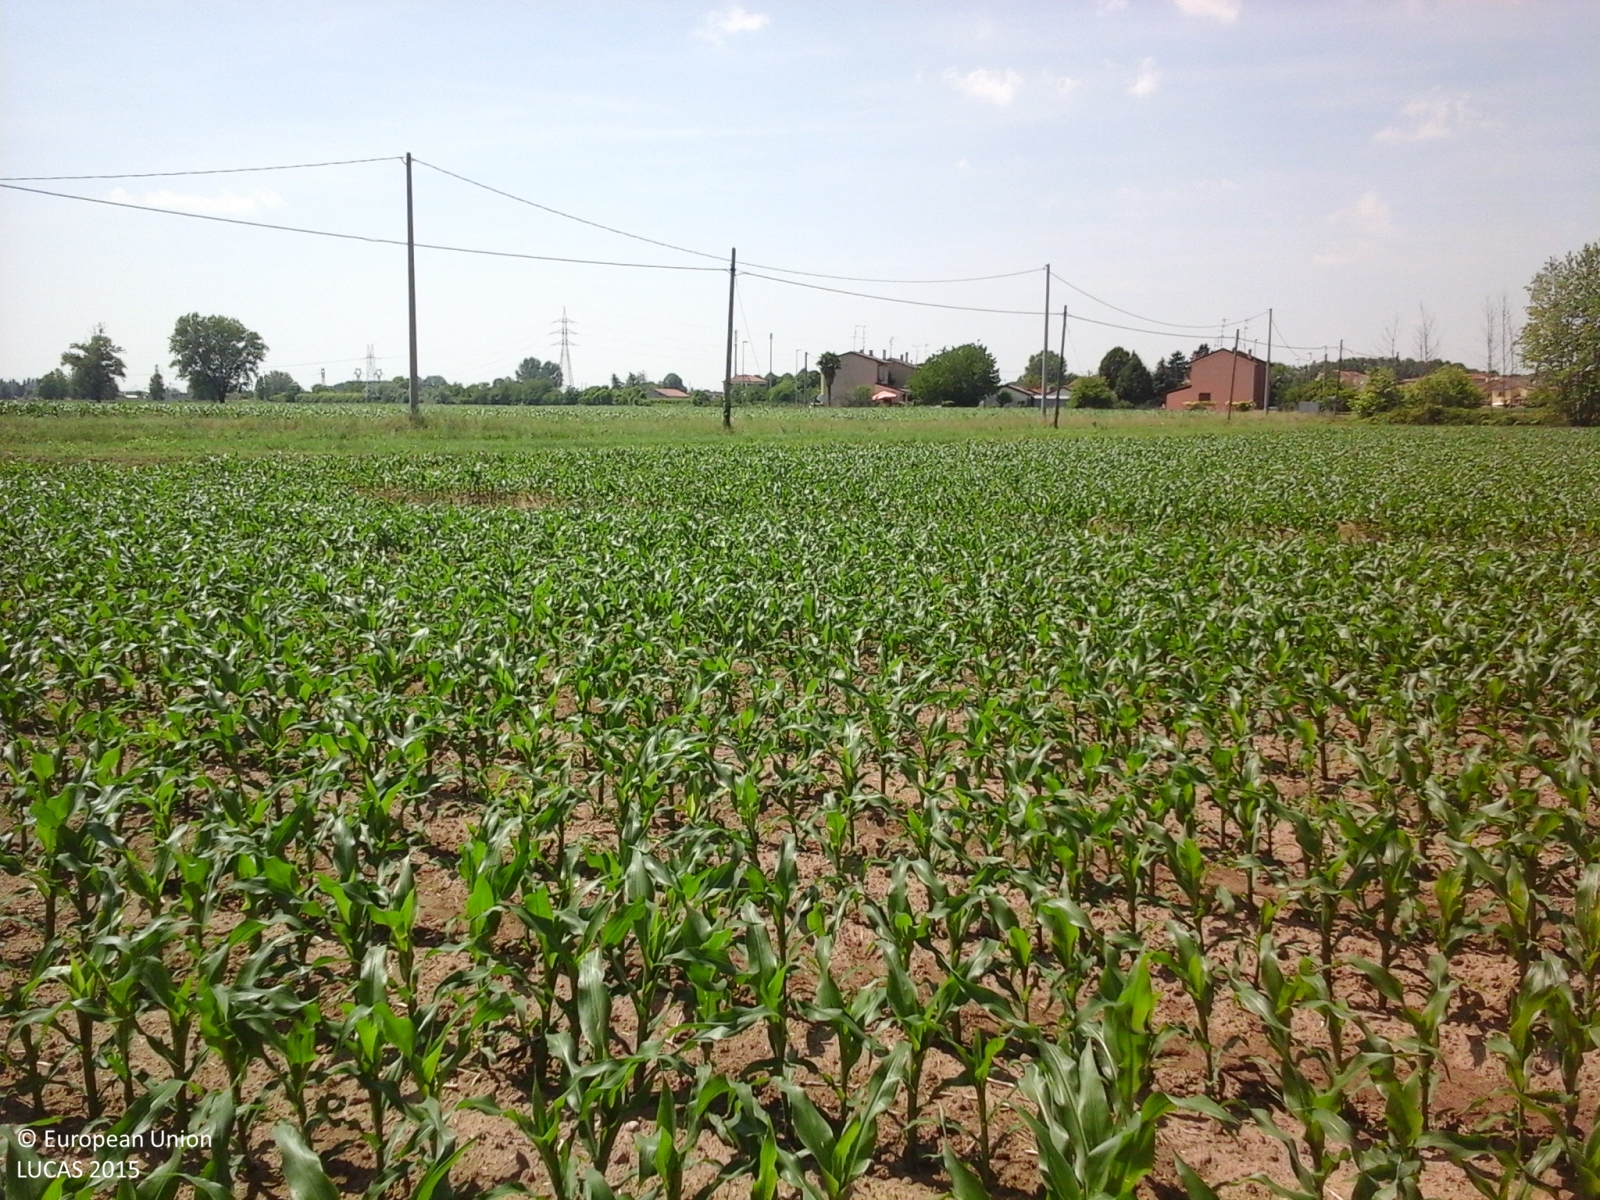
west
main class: Cropland
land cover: Maize
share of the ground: 25 - 50 %
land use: Agriculture (excluding fallow land and kitchen gardens)
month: May
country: IT
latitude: 45.1761
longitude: 10.9018
